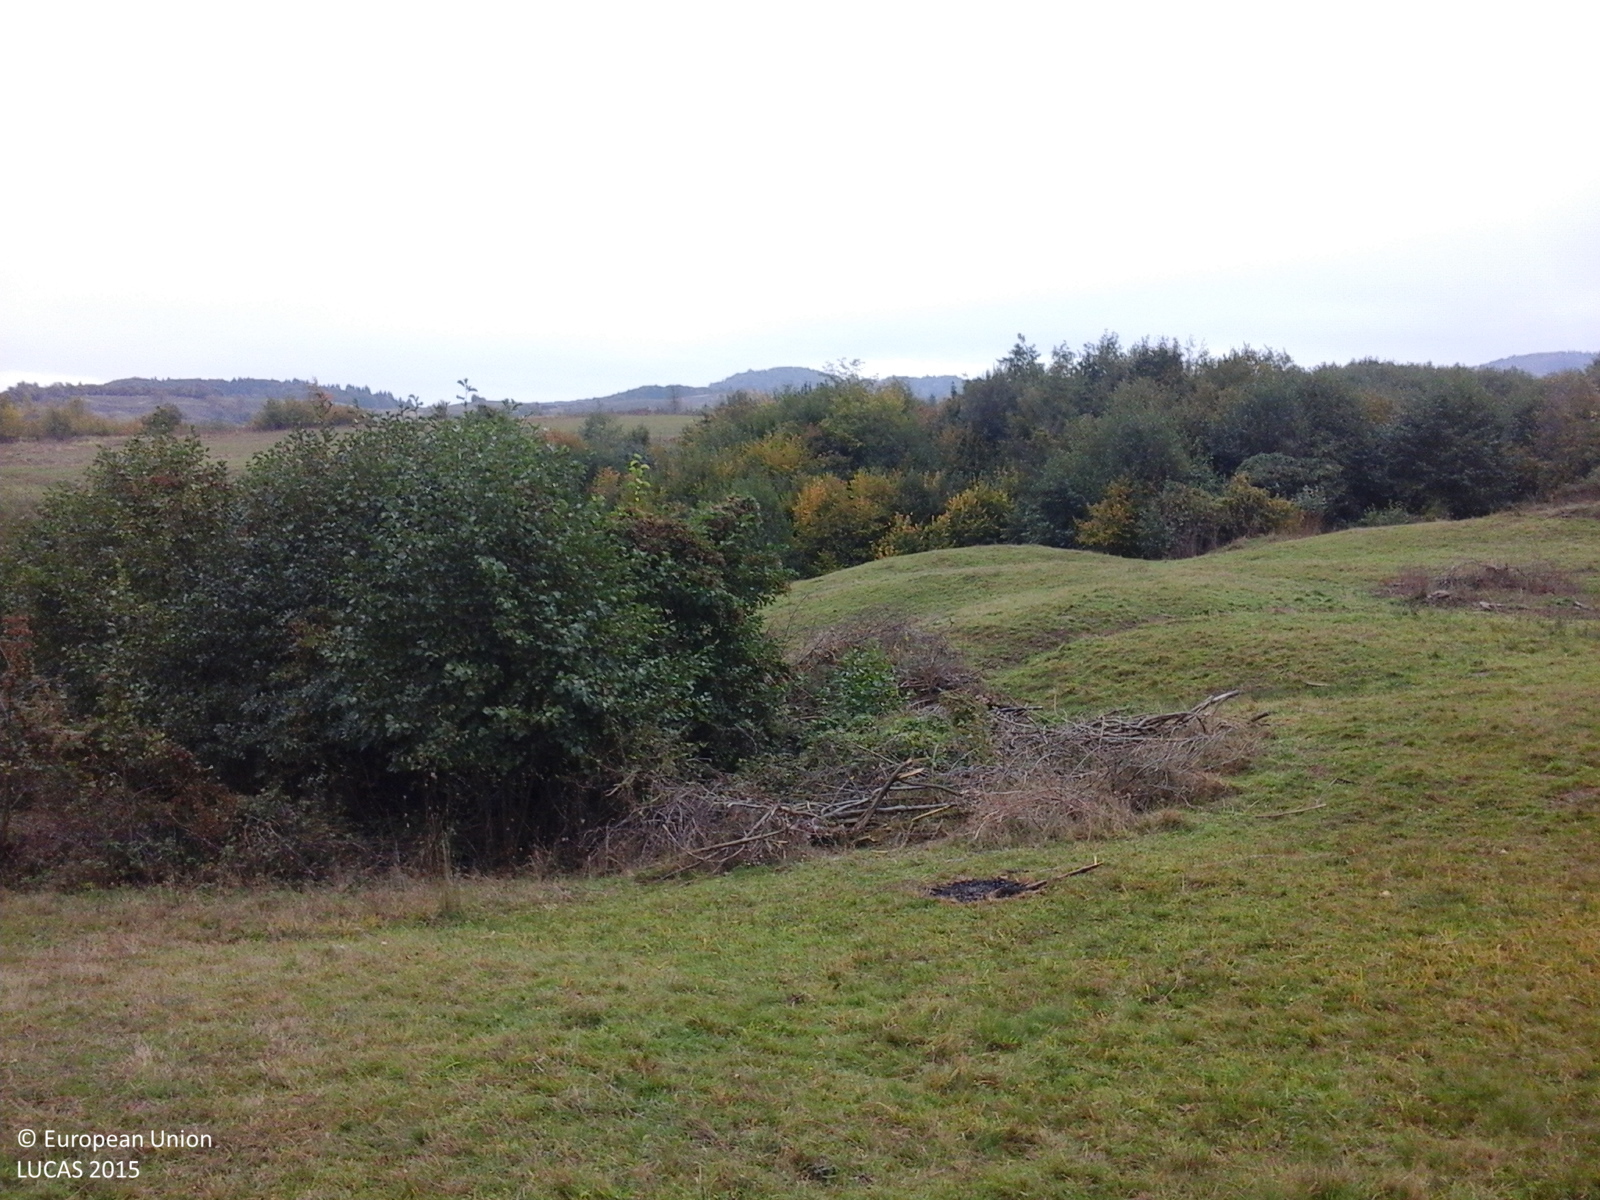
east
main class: Grassland
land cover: Grassland without tree/shrub cover
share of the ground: > 75 %
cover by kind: herbaceous plants 100 %
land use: Agriculture (excluding fallow land and kitchen gardens)
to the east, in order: Grassland without tree/shrub cover; Grassland with sparse tree/shrub cover; Spontaneously vegetated surfaces; Broadleaved woodland; Grassland without tree/shrub cover; Other bare soil; Grassland without tree/shrub cover; Broadleaved woodland; Shrubland with sparse tree cover
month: October
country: RO
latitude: 46.6508
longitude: 24.9273
